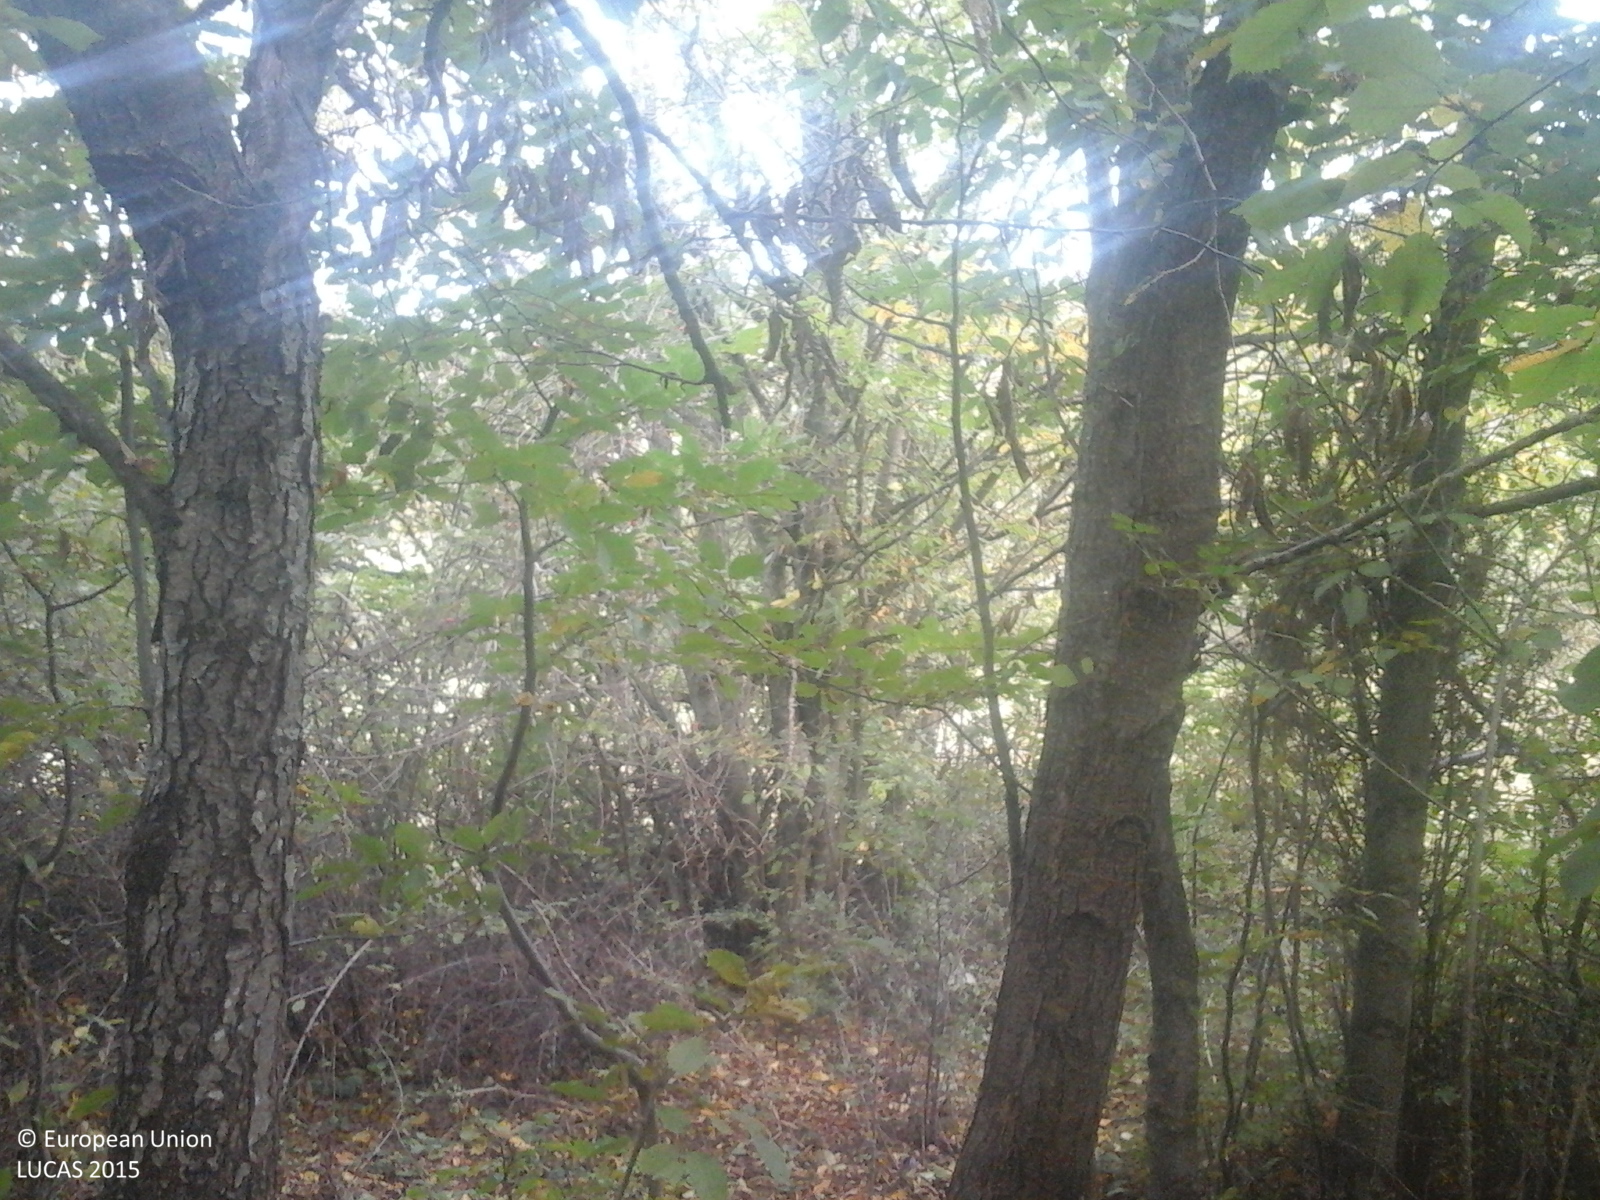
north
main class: Woodland
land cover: Broadleaved woodland
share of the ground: > 75 %
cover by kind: broadleaved forest trees 100 %
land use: Forestry
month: October
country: RO
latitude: 46.1234
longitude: 25.4134
